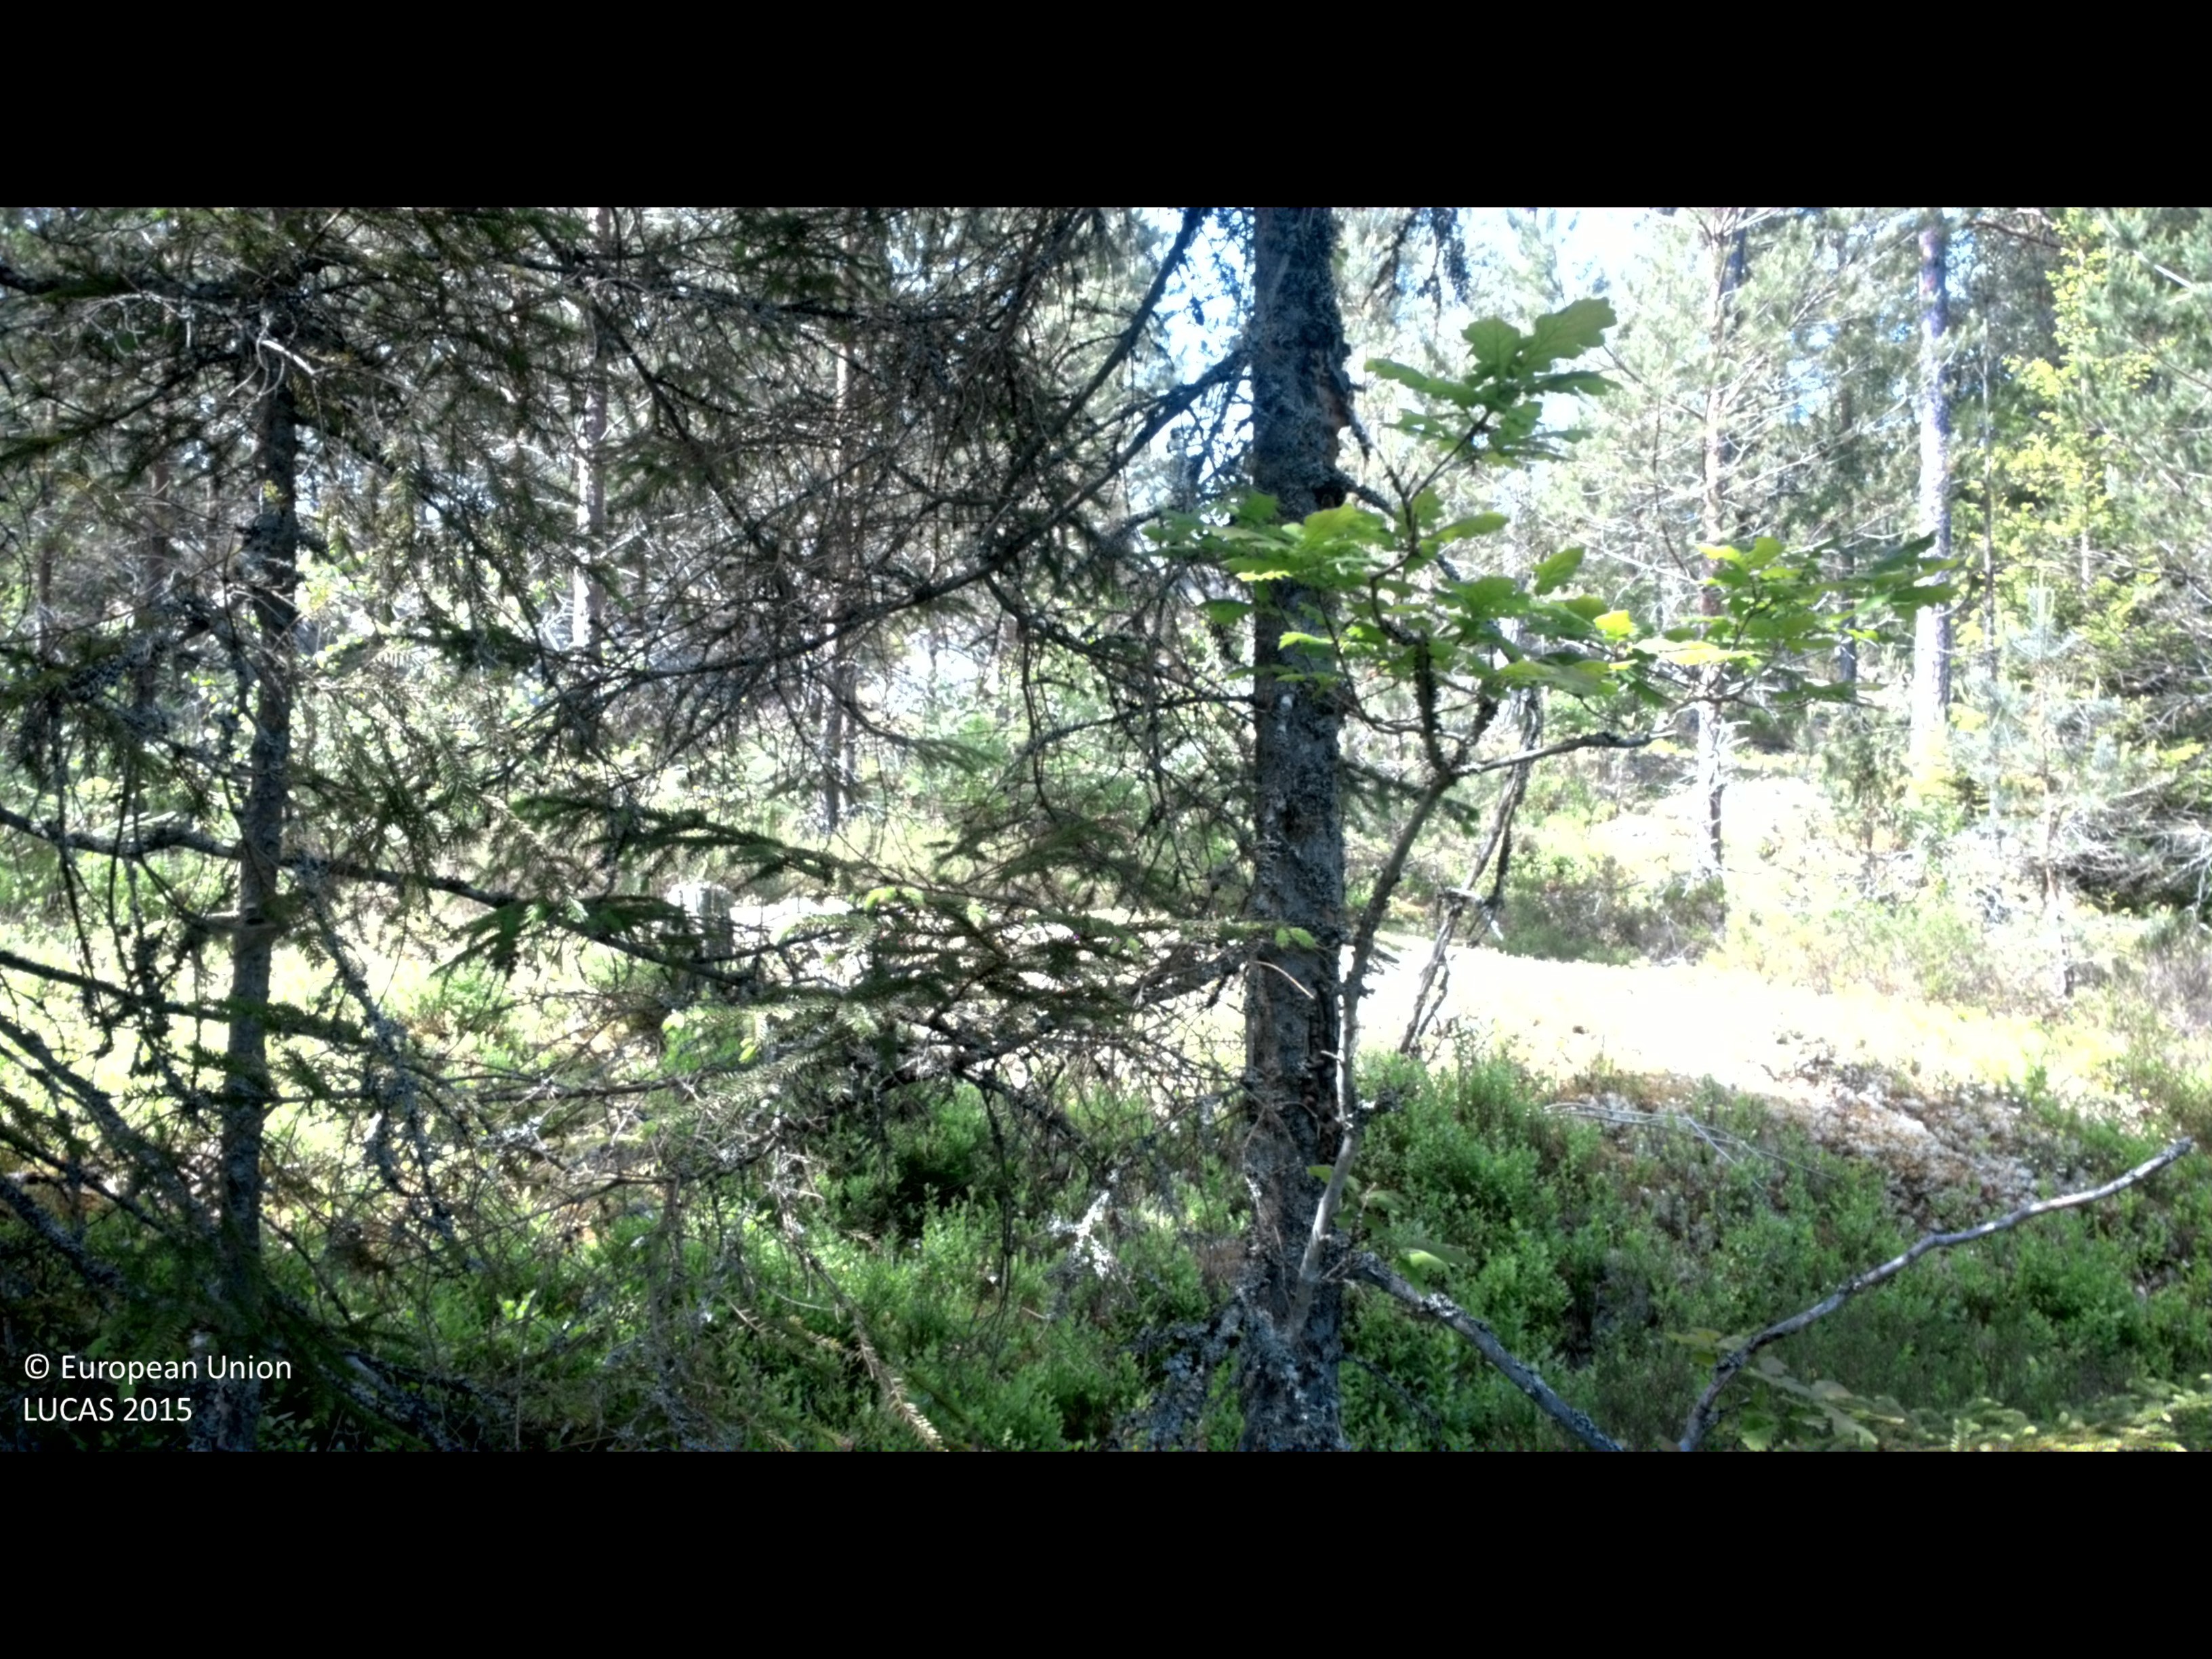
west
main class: Woodland
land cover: Spruce dominated coniferous woodland
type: boreal forest
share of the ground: 50 - 75 %
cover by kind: coniferous forest trees 45 %, shrubs 35 %, broadleaved forest trees 10 %, lichens and mosses 10 %
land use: Forestry
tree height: > 5 m
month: June
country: SE
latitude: 57.6463
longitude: 16.5162
